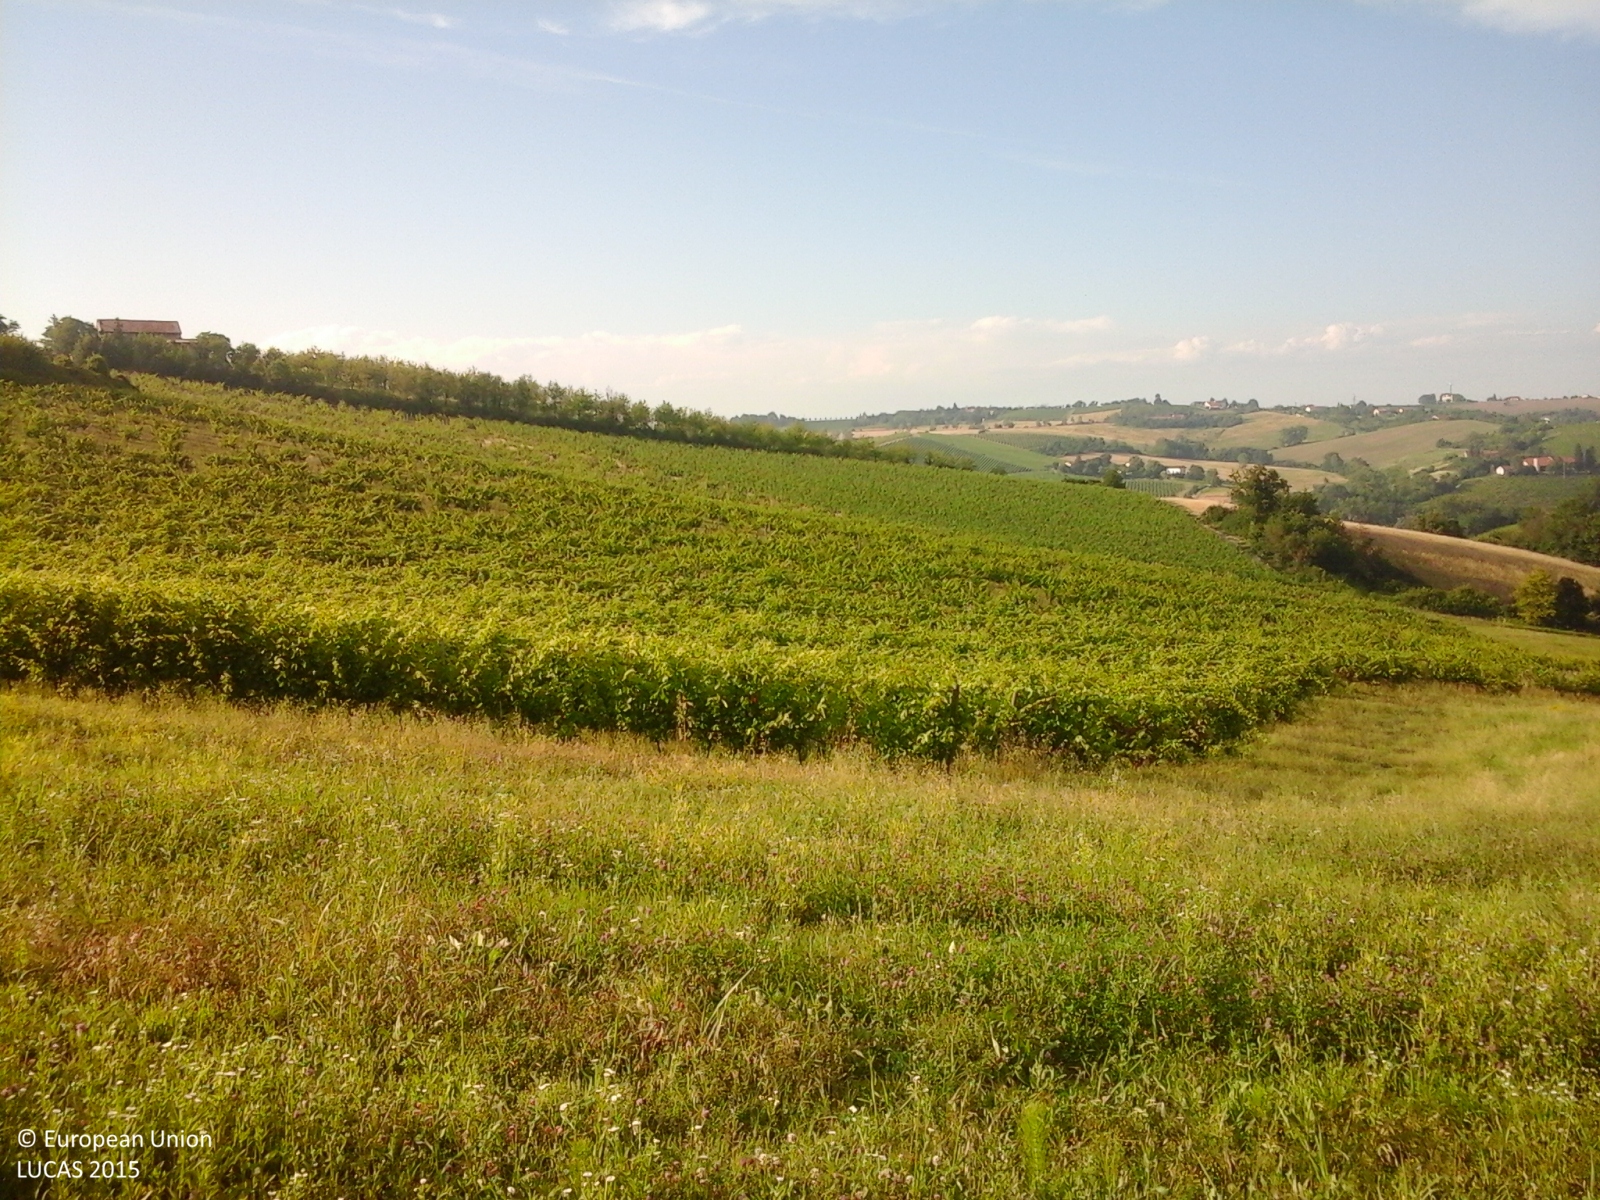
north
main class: Woodland
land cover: Broadleaved woodland
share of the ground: > 75 %
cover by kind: broadleaved forest trees 75 %, shrubs 25 %
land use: Semi-natural and natural areas not in use
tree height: > 5 m
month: June
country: IT
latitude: 45.0955
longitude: 8.3892
